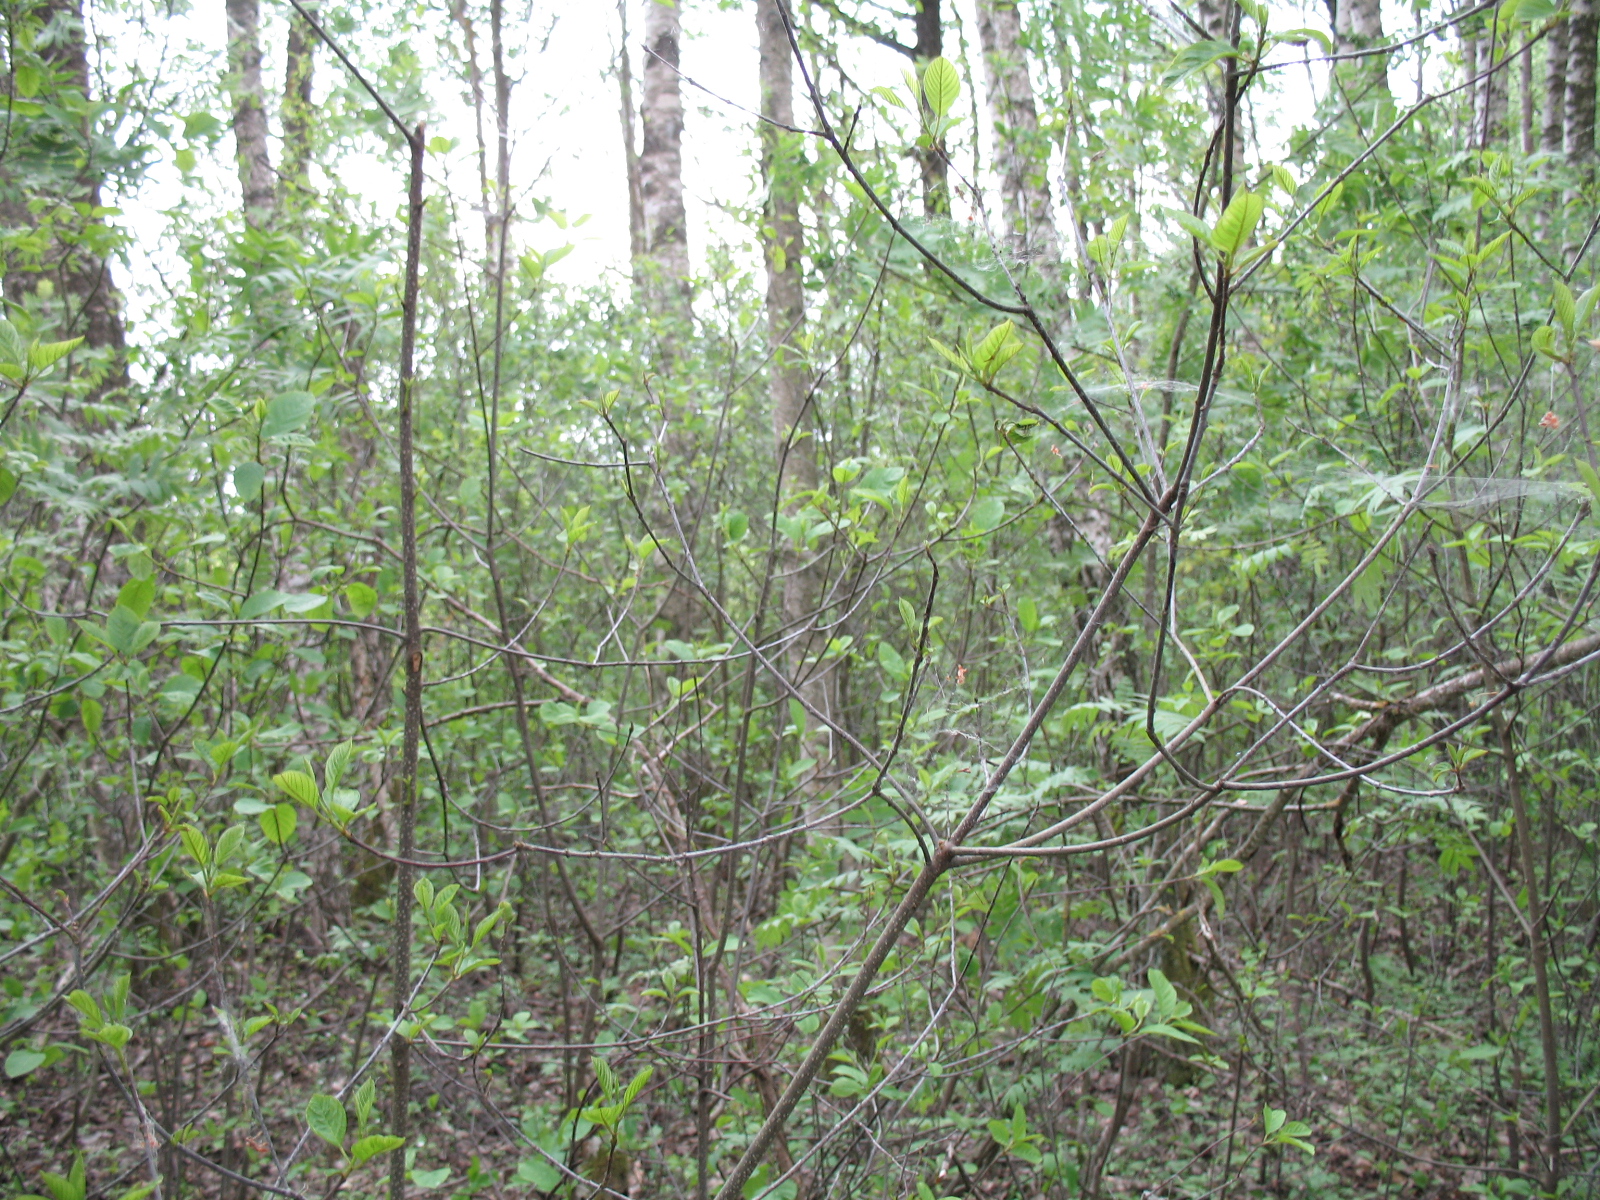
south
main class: Woodland
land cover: Broadleaved woodland
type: non-riverine alder, birch or aspen forest
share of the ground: > 75 %
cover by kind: broadleaved forest trees 95 %, shrubs 5 %
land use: Forestry
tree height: > 5 m
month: May
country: LV
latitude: 56.7803
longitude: 23.5442
